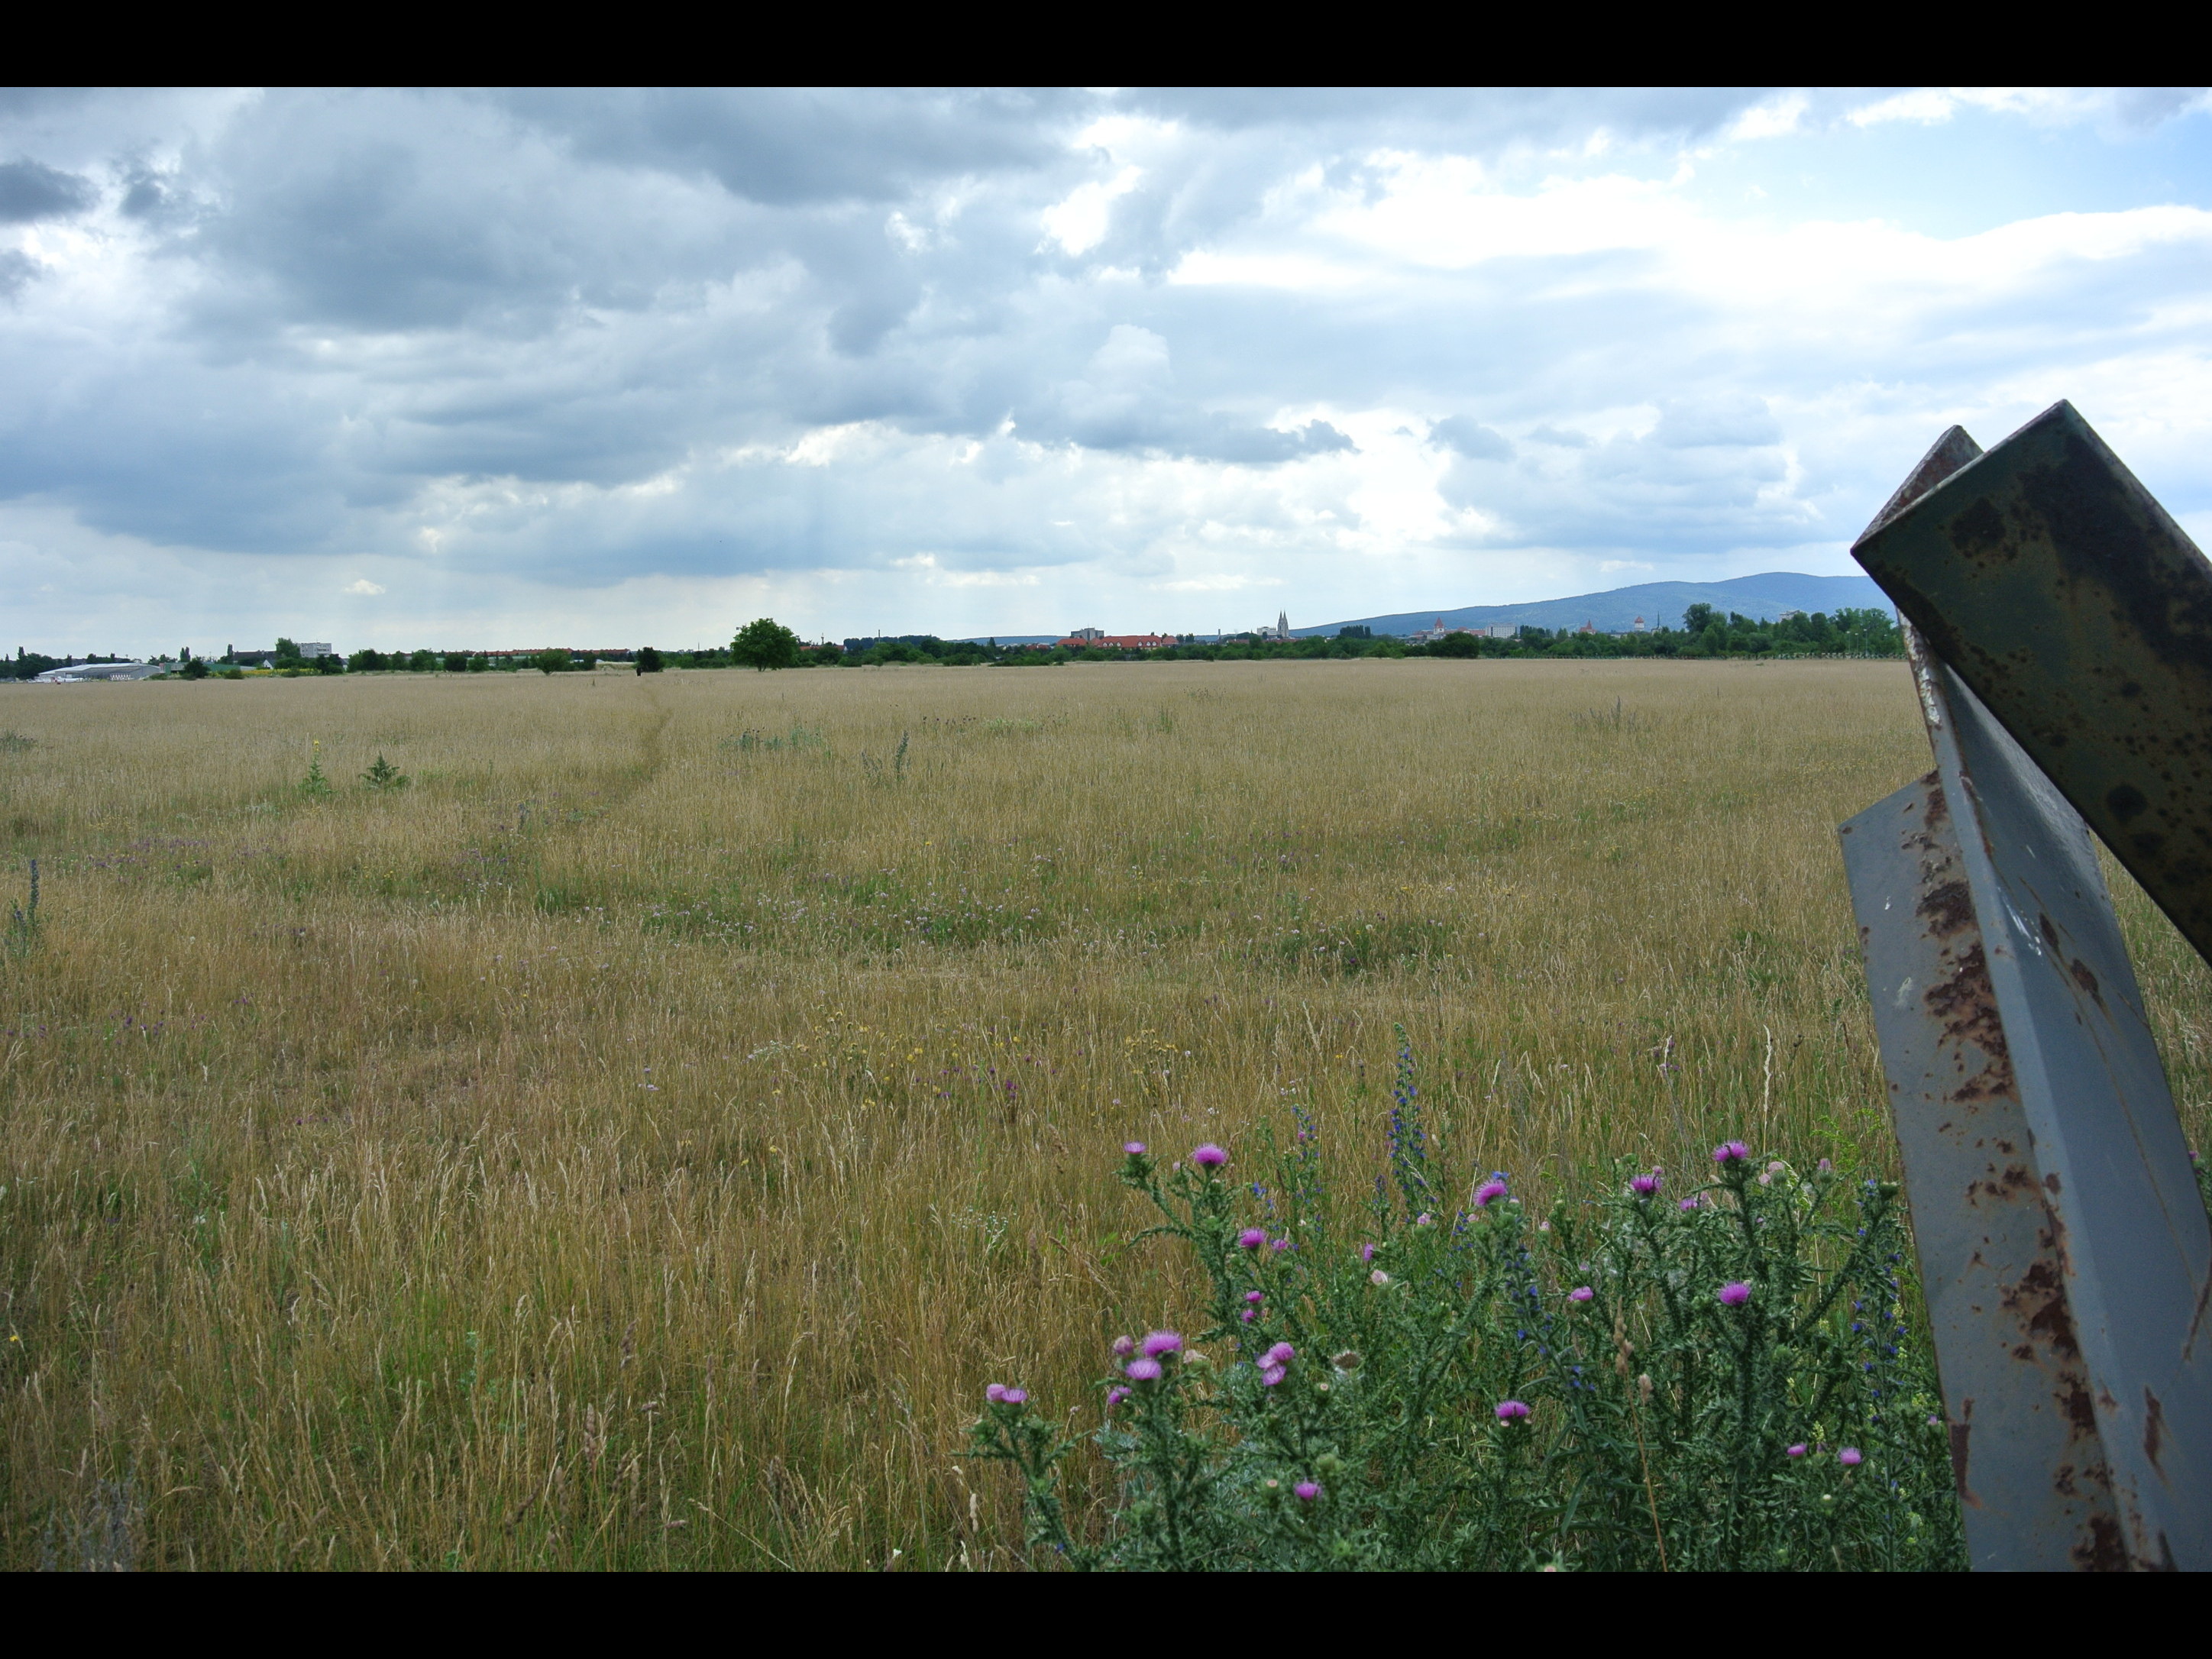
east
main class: Grassland
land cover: Grassland without tree/shrub cover
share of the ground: > 75 %
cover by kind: herbaceous plants 100 %
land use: Air transport
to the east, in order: Grassland without tree/shrub cover
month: June
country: AT
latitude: 47.8316
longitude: 16.2157
